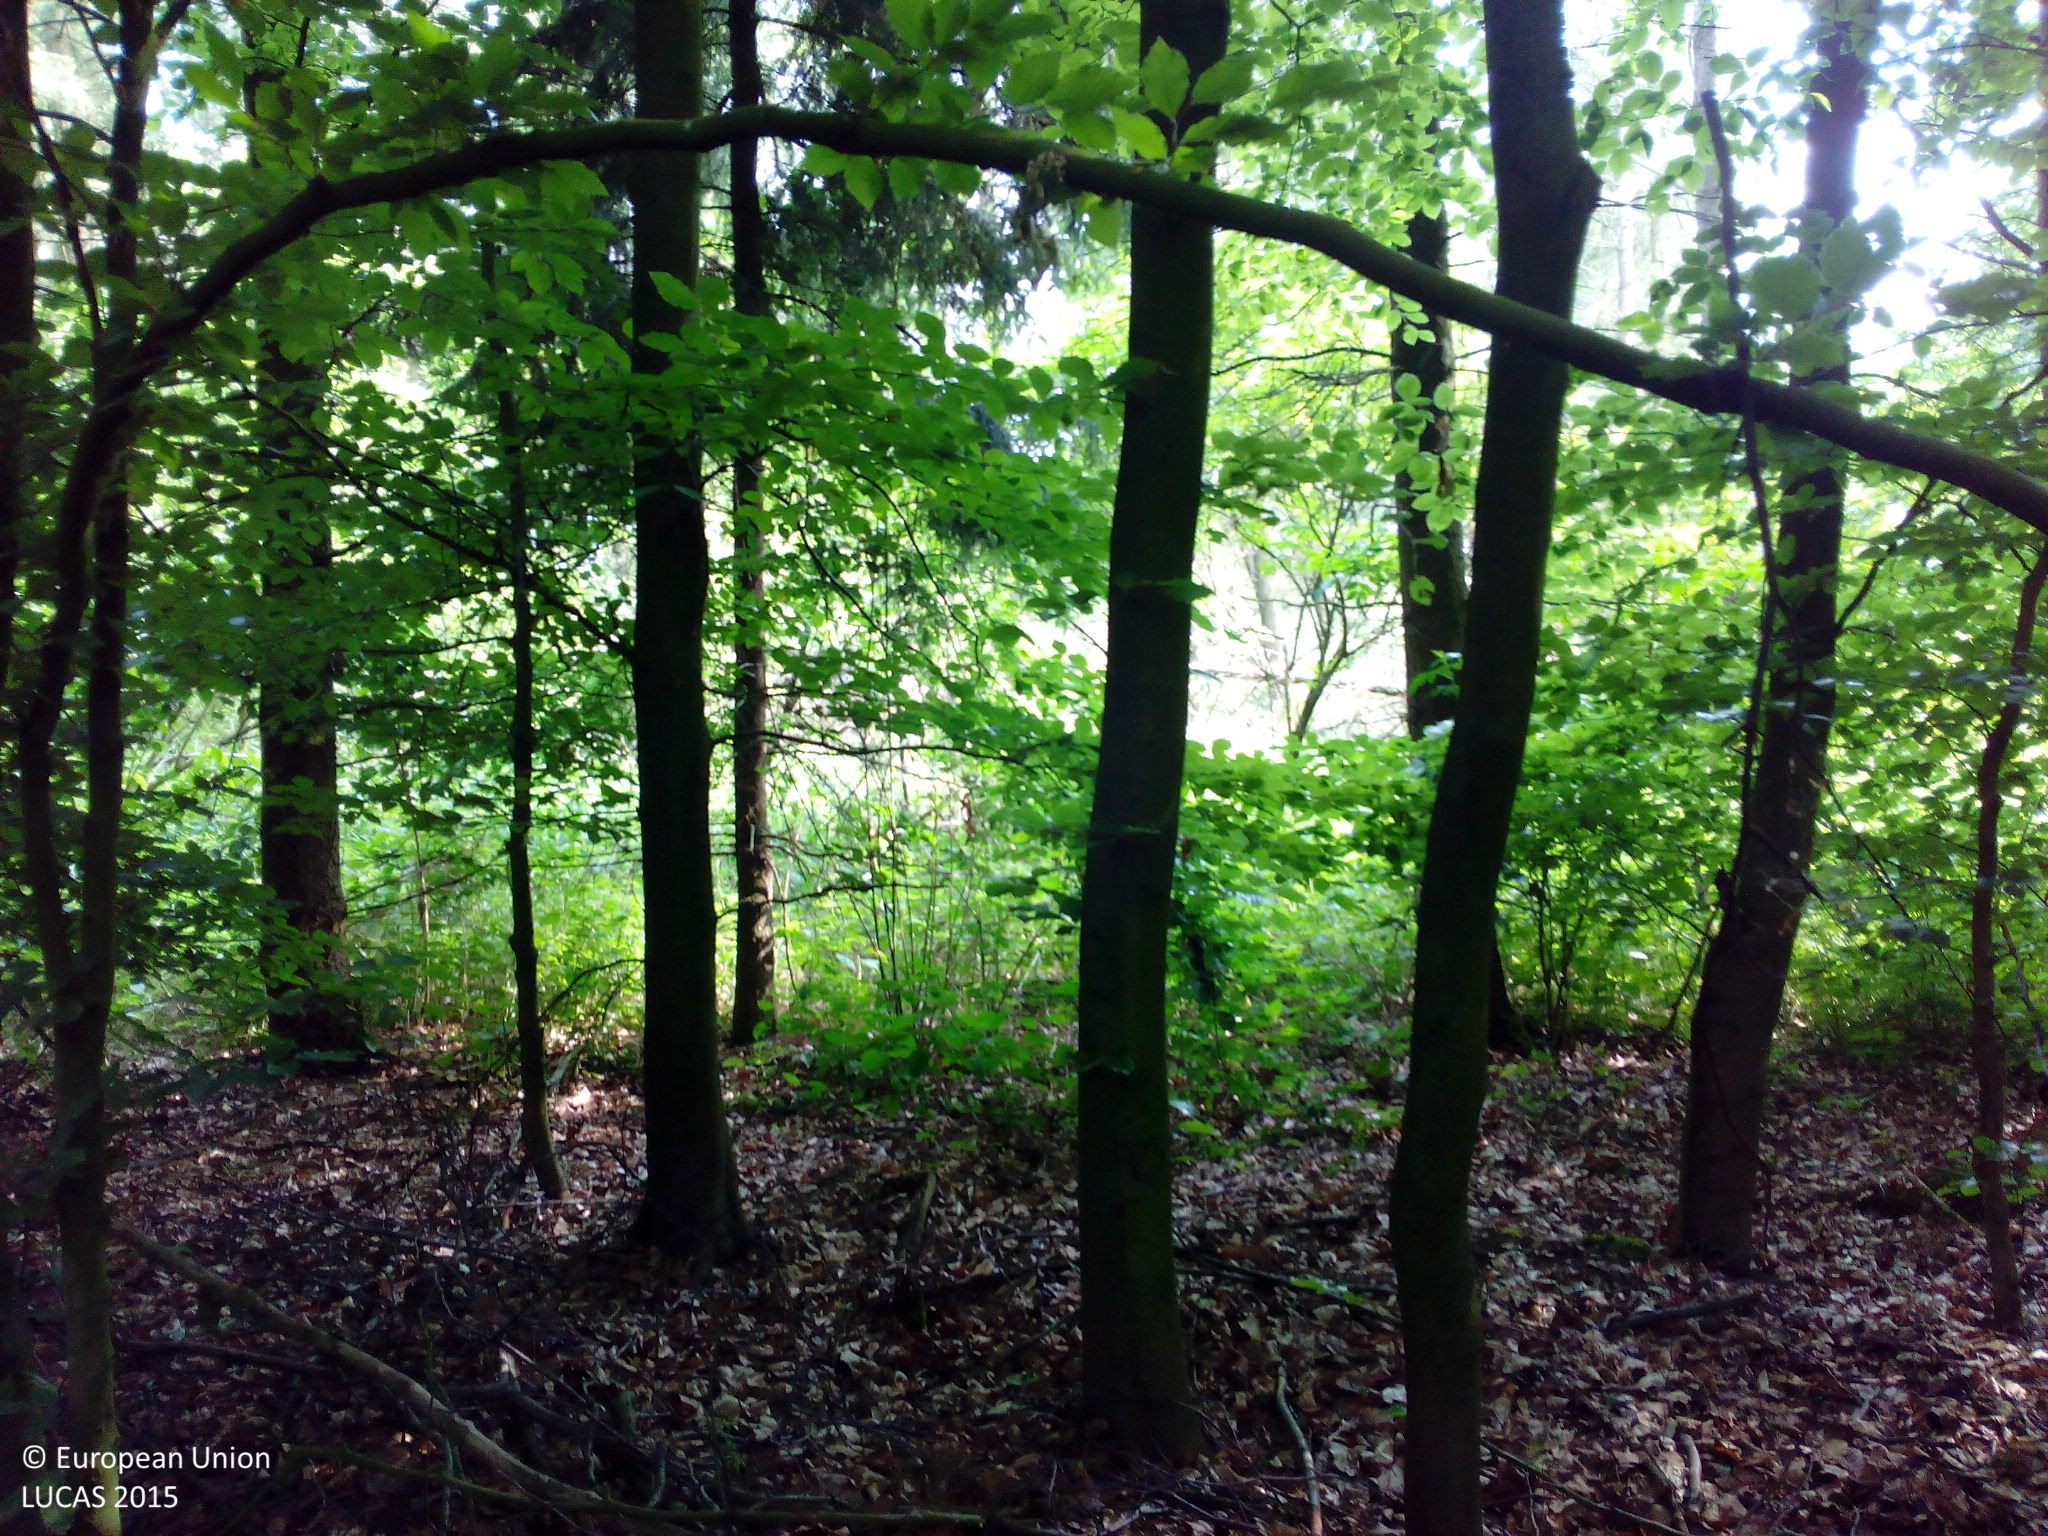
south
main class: Woodland
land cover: Broadleaved woodland
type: mesophytic deciduous forest
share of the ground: > 75 %
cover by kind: broadleaved forest trees 100 %
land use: Forestry
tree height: > 5 m
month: June
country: DE
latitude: 52.3324
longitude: 7.4616
